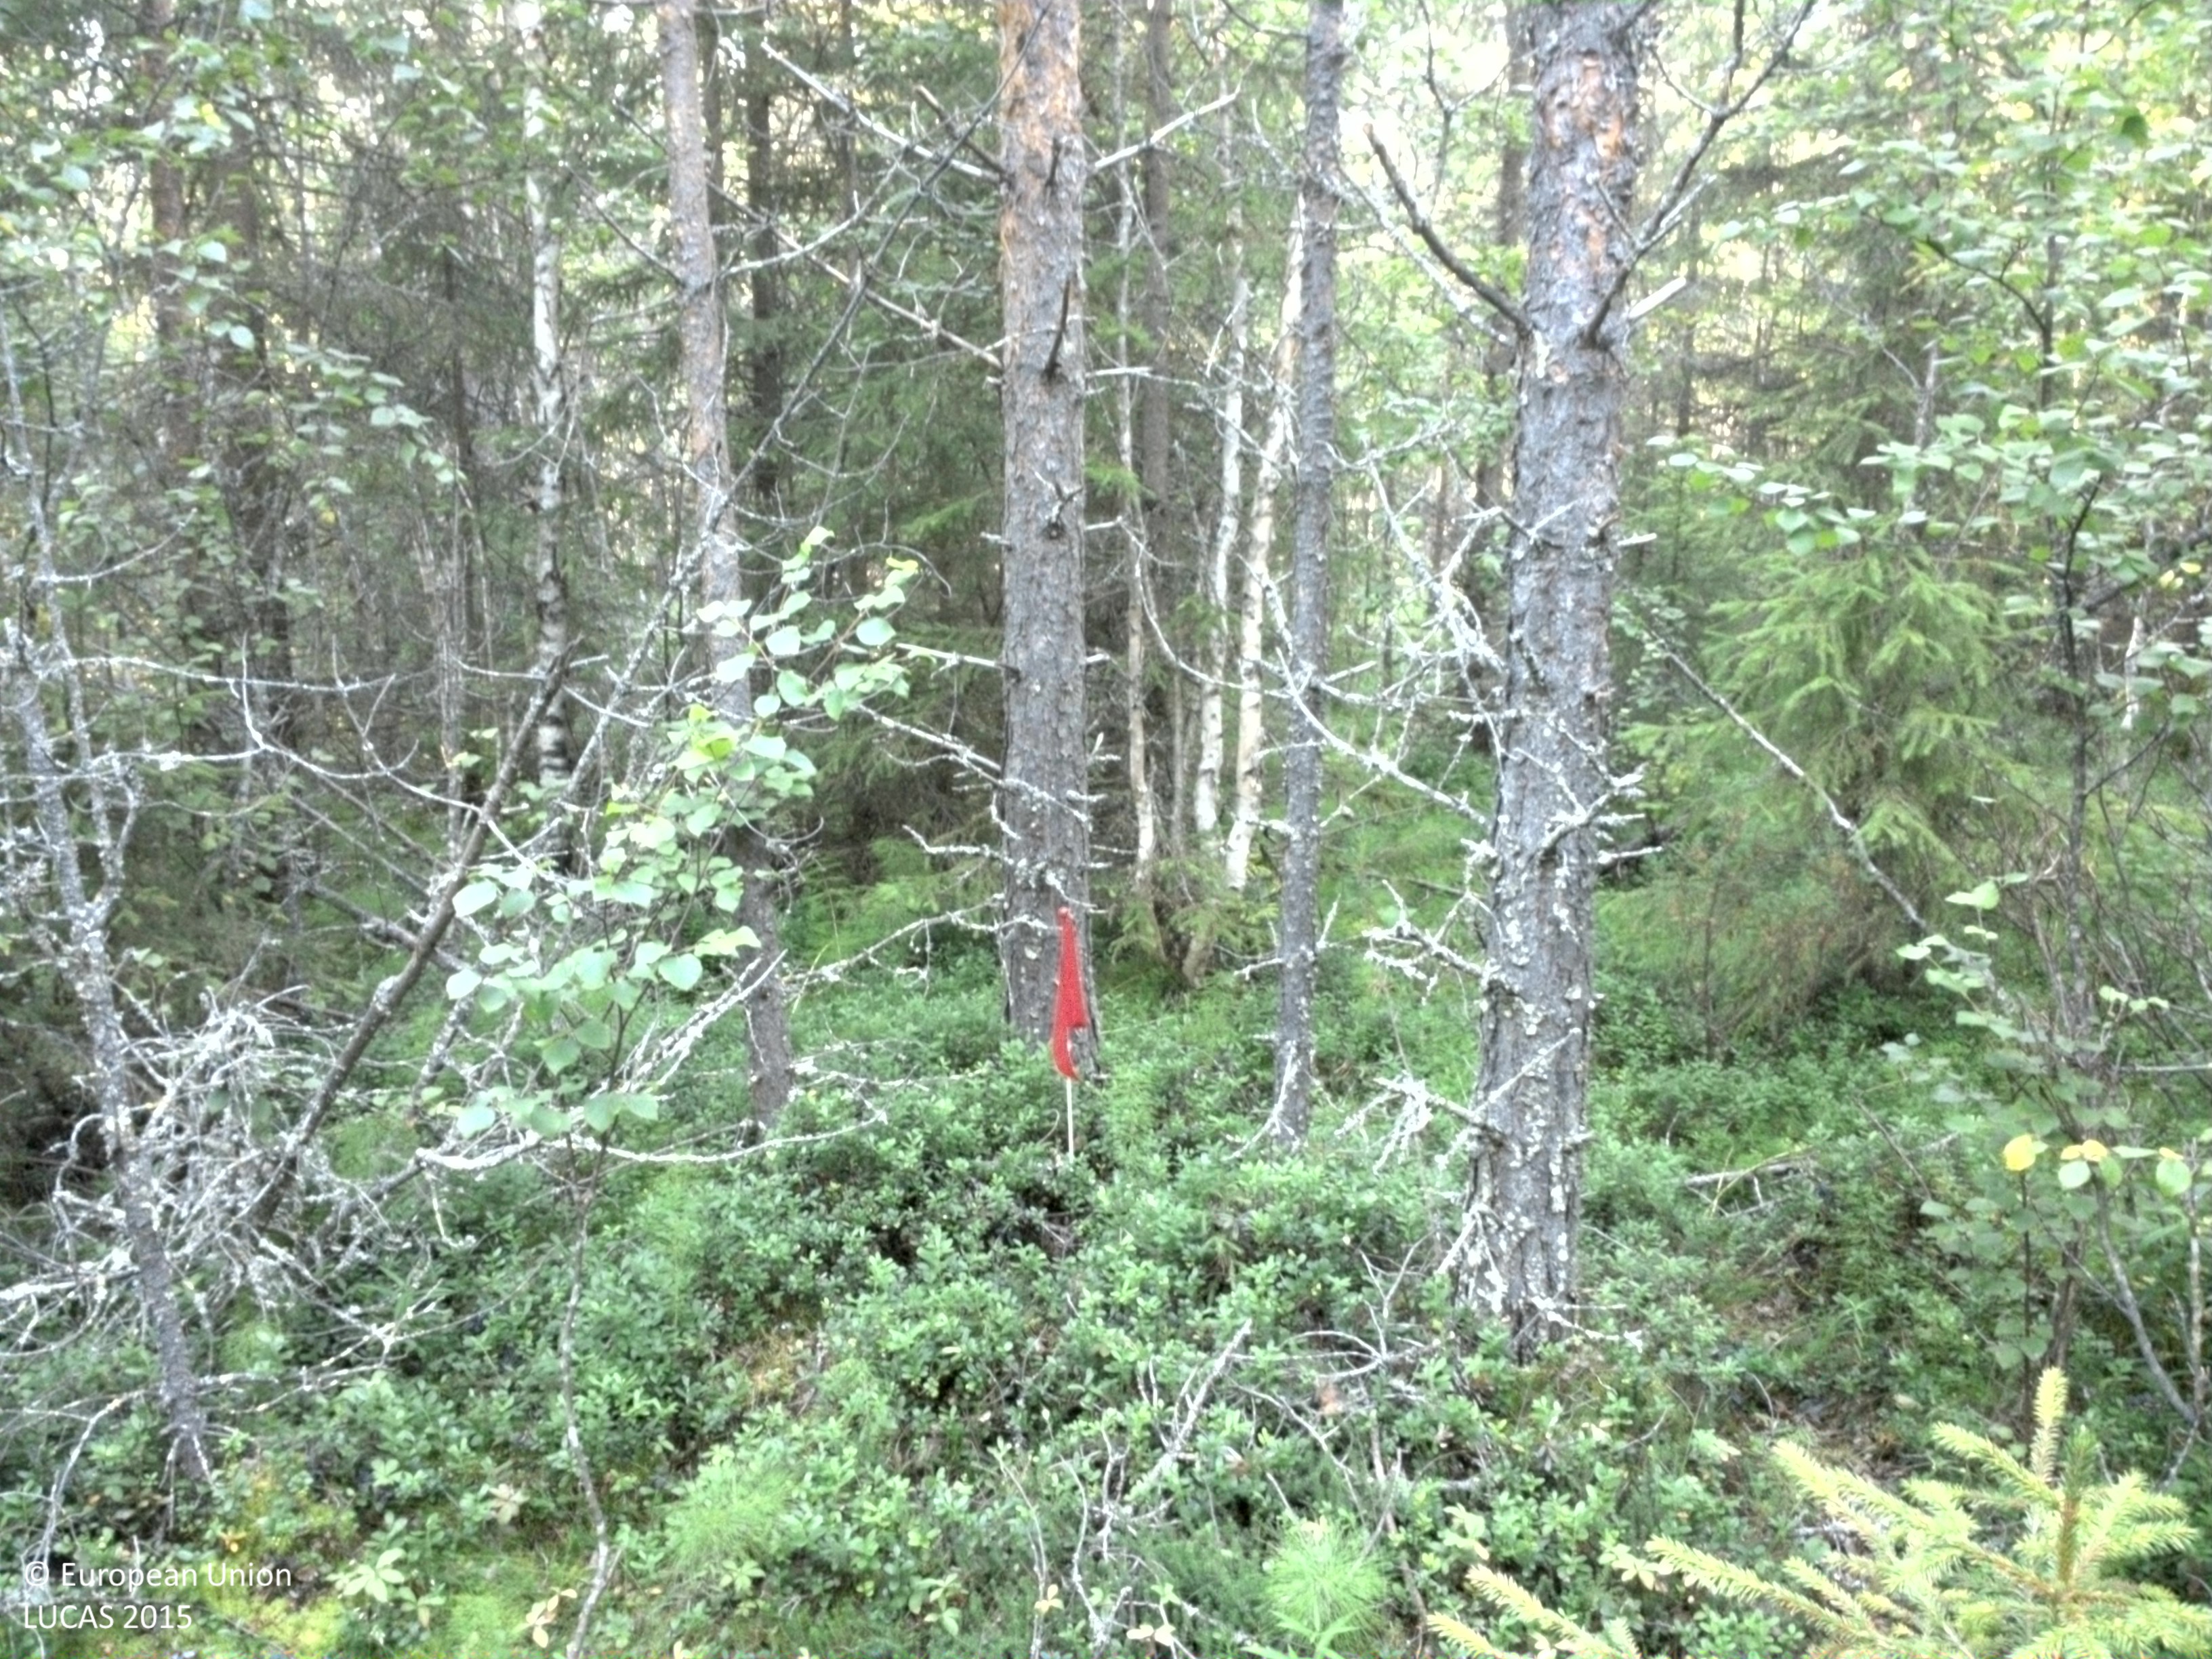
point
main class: Woodland
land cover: Pine dominated mixed woodland
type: boreal forest
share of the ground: > 75 %
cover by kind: coniferous forest trees 60 %, broadleaved forest trees 20 %, shrubs 20 %
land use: Forestry
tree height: > 5 m
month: August
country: SE
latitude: 64.5730
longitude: 20.8544
